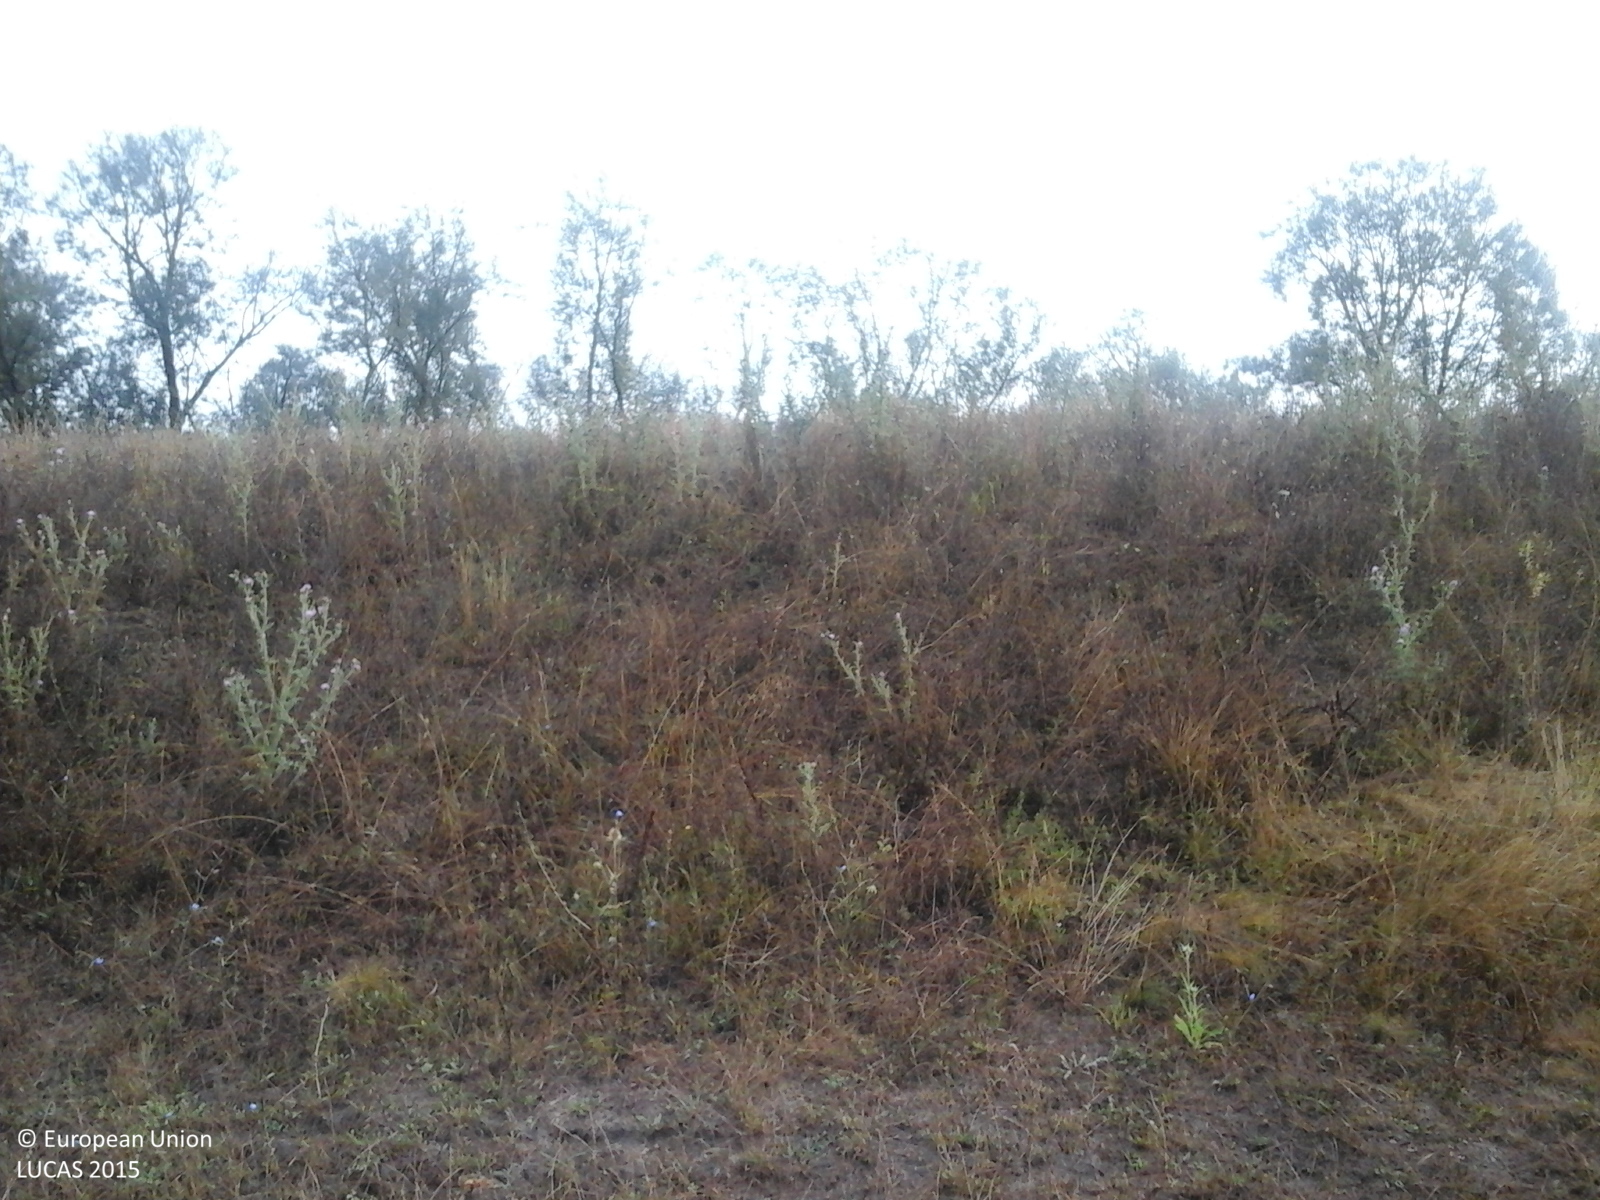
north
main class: Cropland
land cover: Maize
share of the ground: > 75 %
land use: Agriculture (excluding fallow land and kitchen gardens)
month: August
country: RO
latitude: 45.7708
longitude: 21.7779
